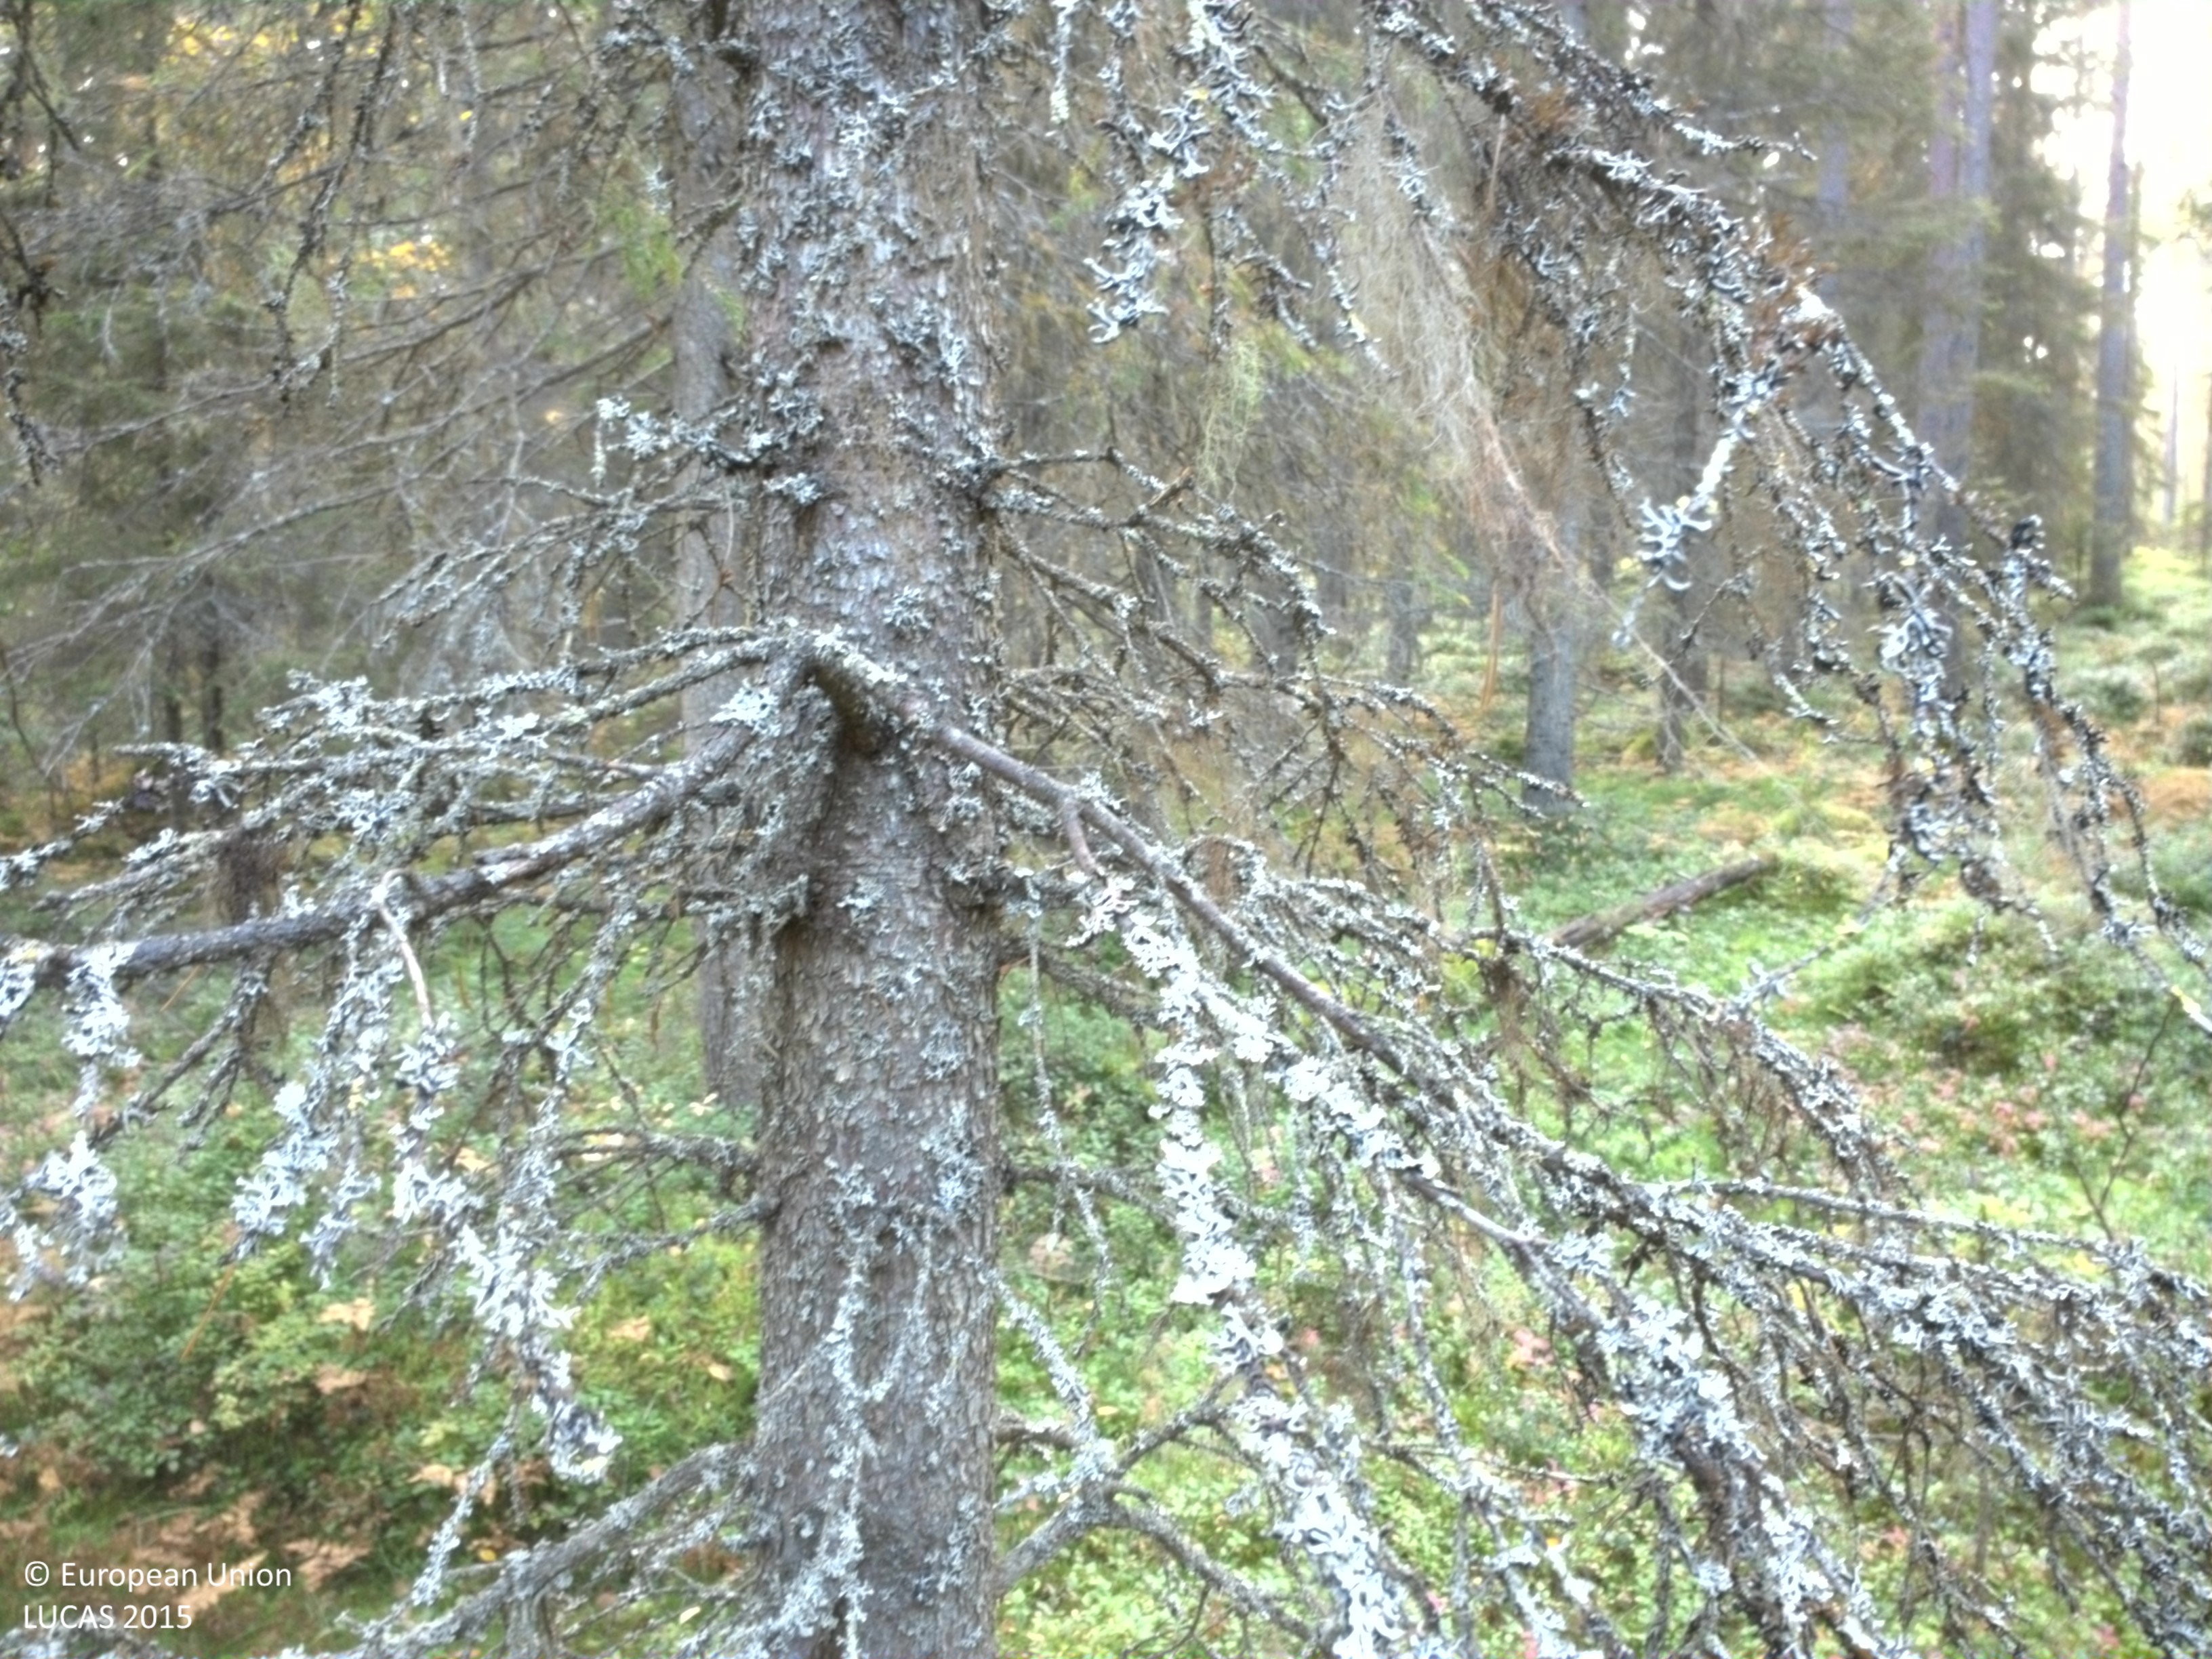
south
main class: Woodland
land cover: Spruce dominated coniferous woodland
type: boreal forest
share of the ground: 25 - 50 %
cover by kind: shrubs 50 %, coniferous forest trees 40 %, lichens and mosses 10 %
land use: Forestry
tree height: > 5 m
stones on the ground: < 10 %
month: September
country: SE
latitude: 65.5097
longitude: 21.8464
